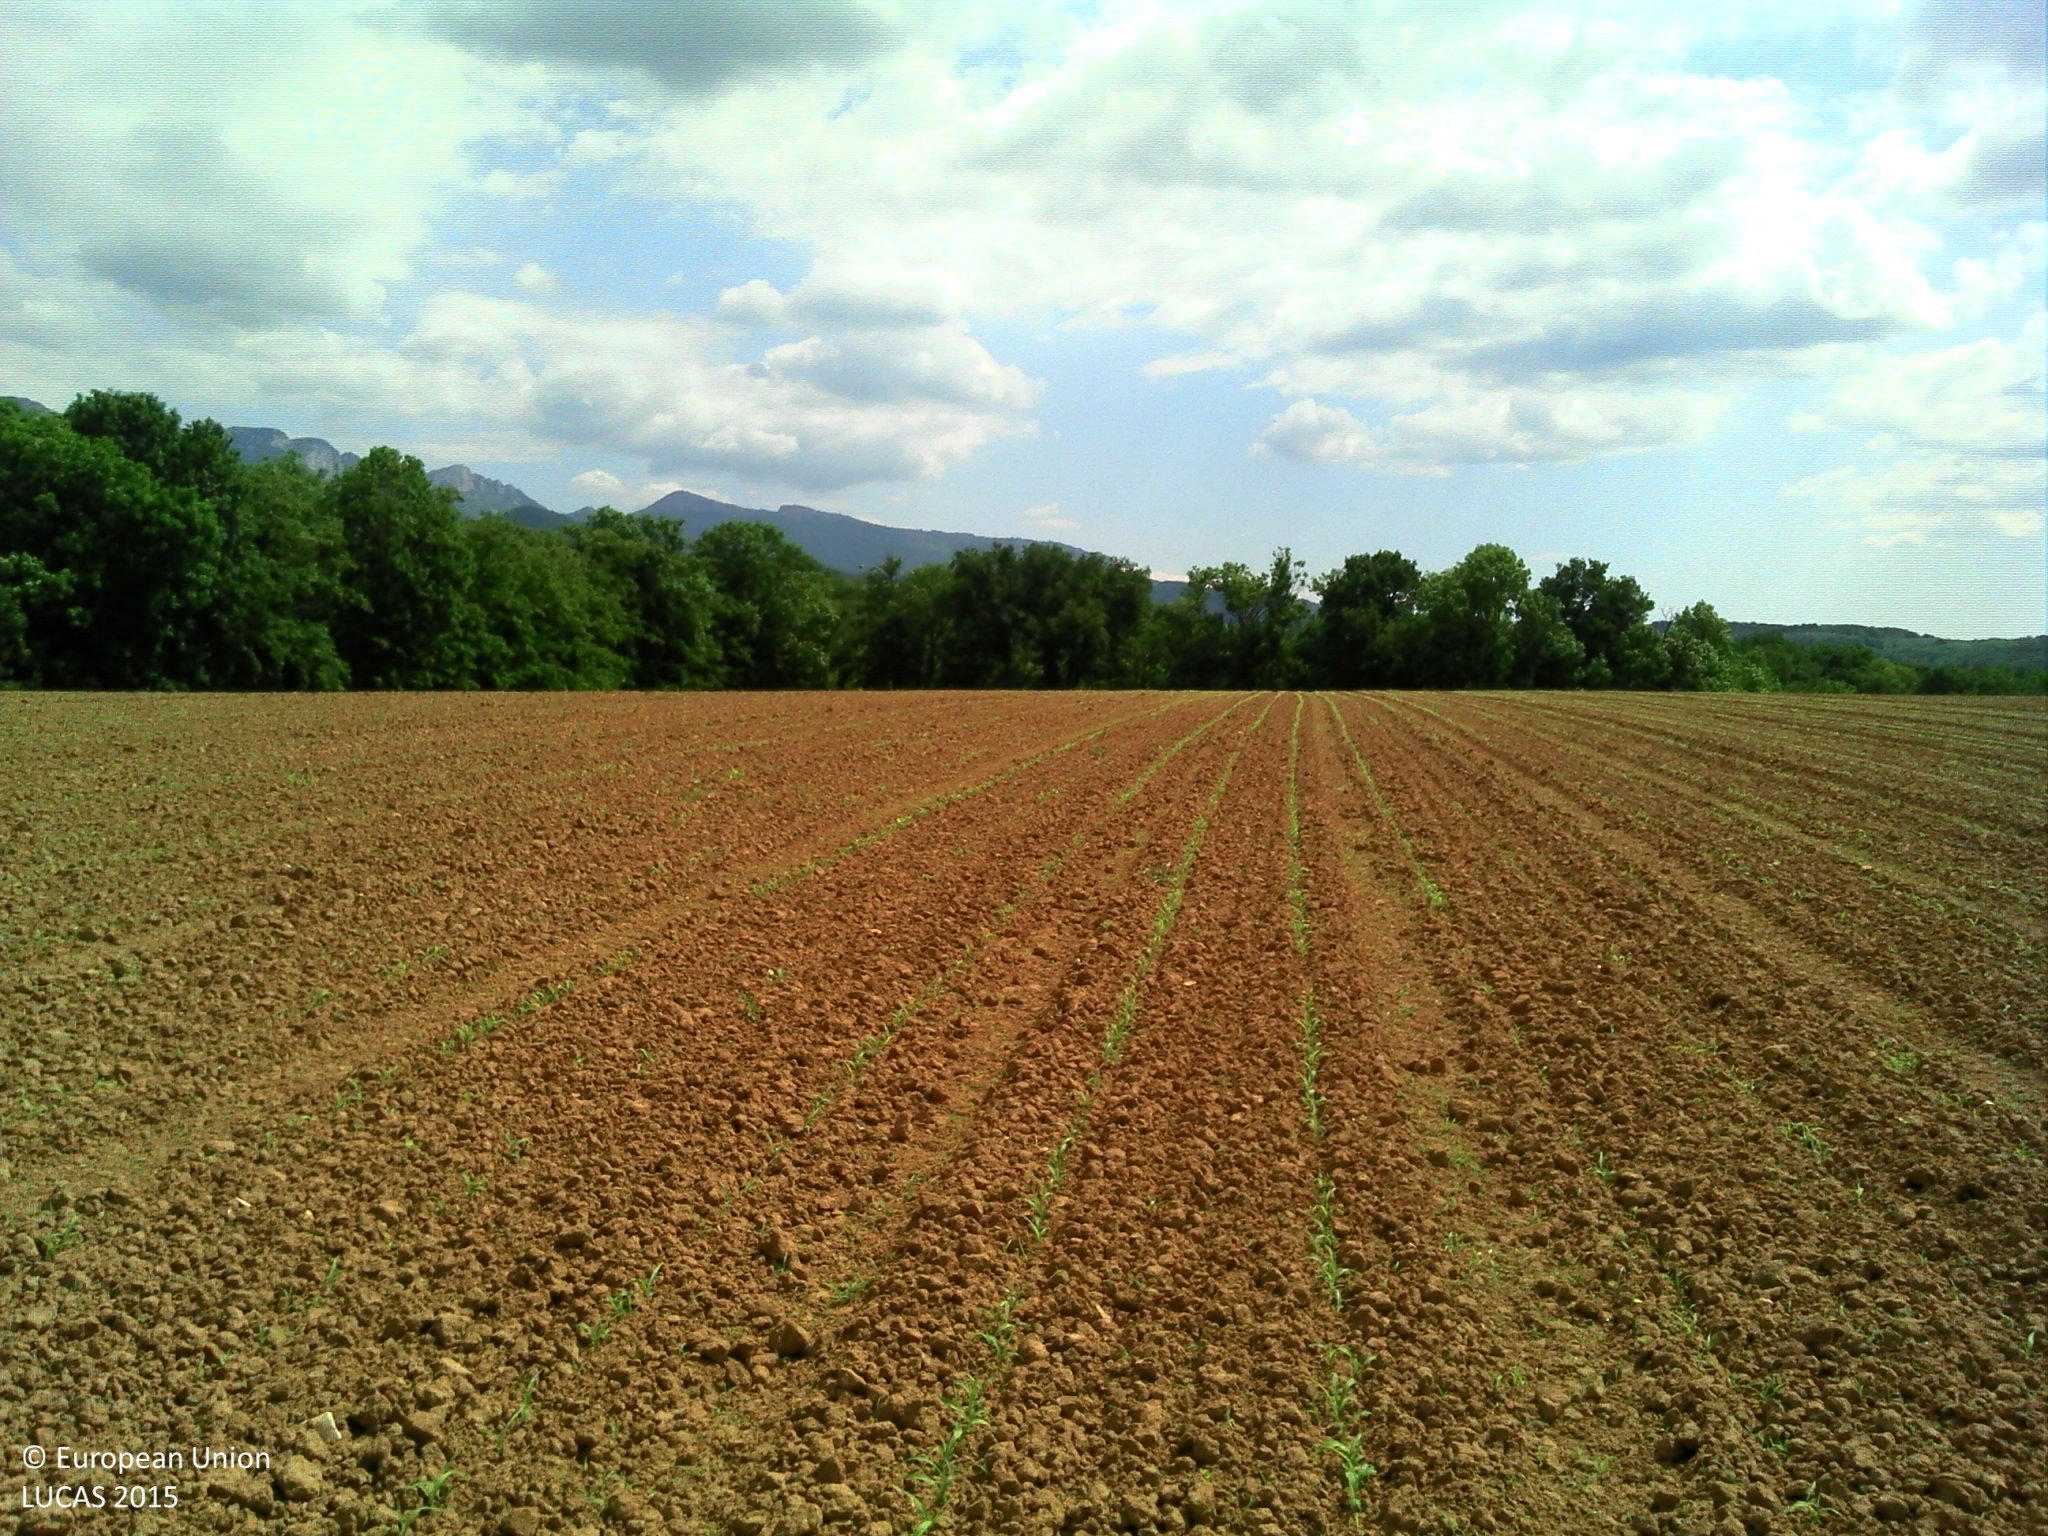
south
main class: Cropland
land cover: Maize
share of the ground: < 10 %
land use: Agriculture (excluding fallow land and kitchen gardens)
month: May
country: FR
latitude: 45.0136
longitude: 5.1458
